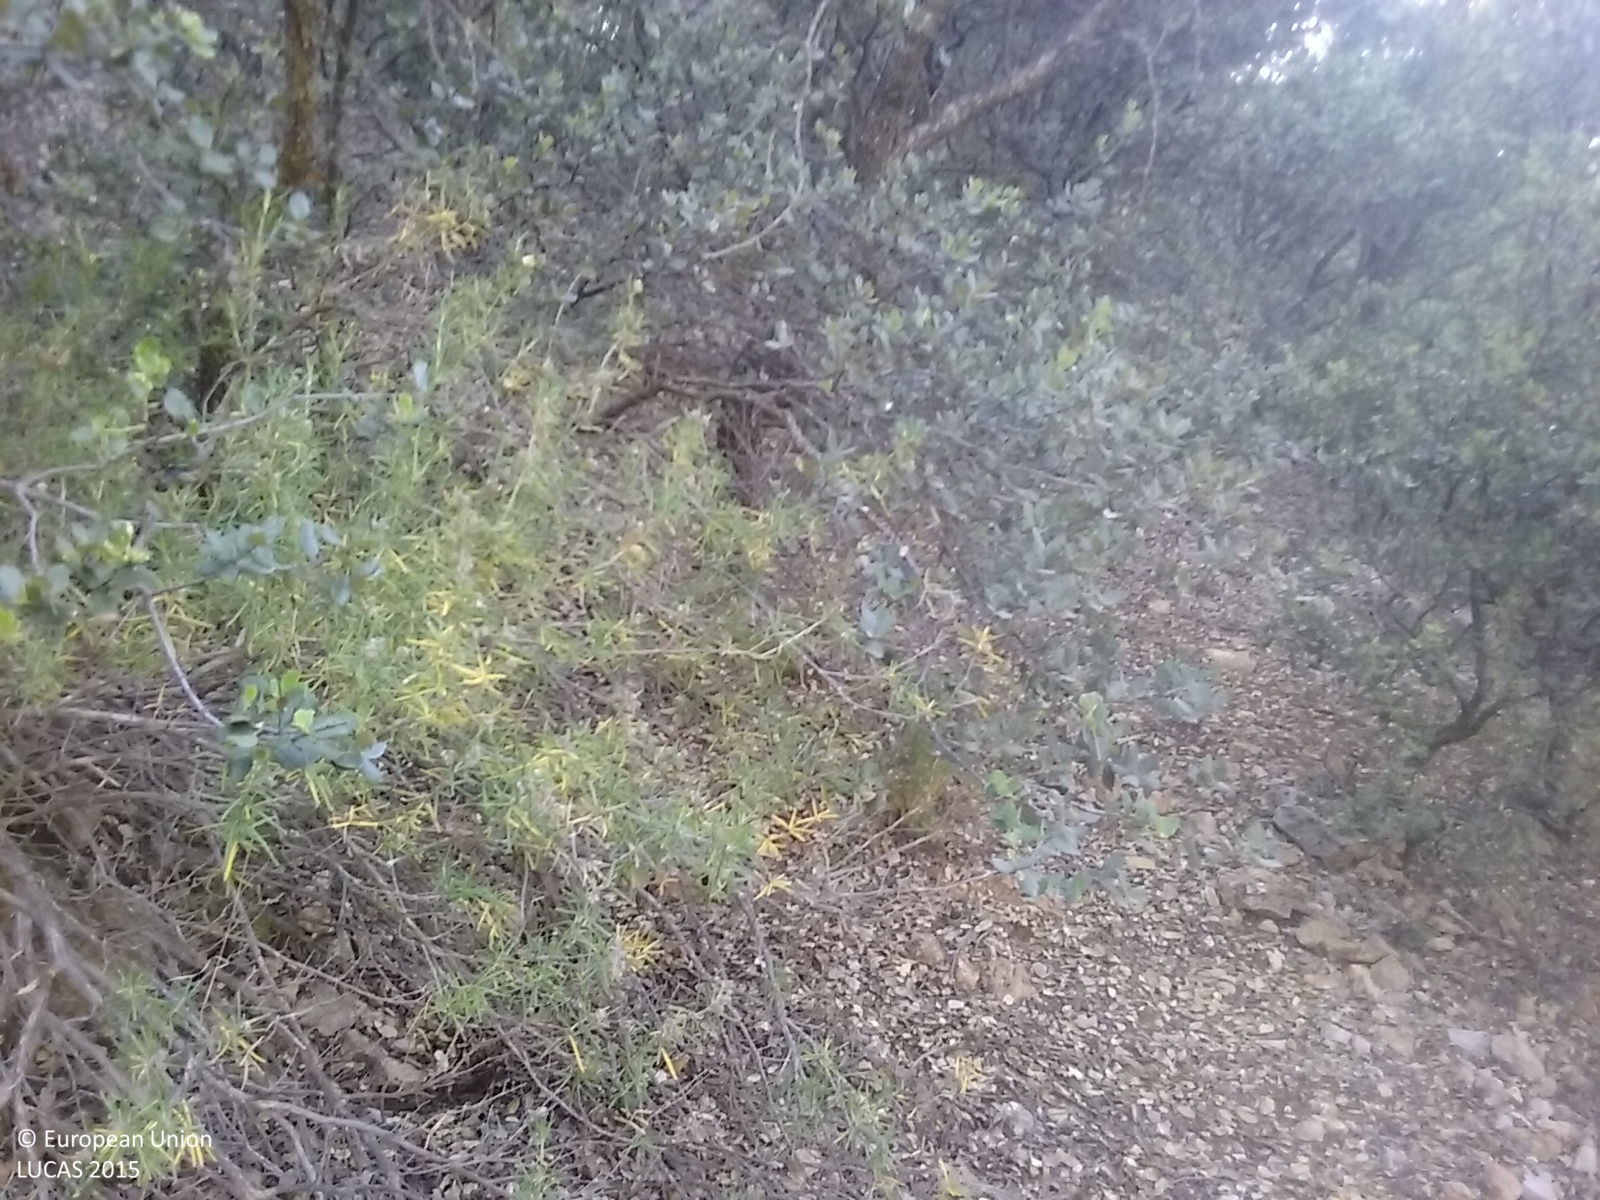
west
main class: Woodland
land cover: Pine dominated mixed woodland
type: coniferous forest of the mediterranean region
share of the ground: > 75 %
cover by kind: coniferous forest trees 50 %, broadleaved forest trees 40 %, shrubs 10 %
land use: Semi-natural and natural areas not in use
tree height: > 5 m
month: June
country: ES
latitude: 40.7301
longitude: -0.0843
